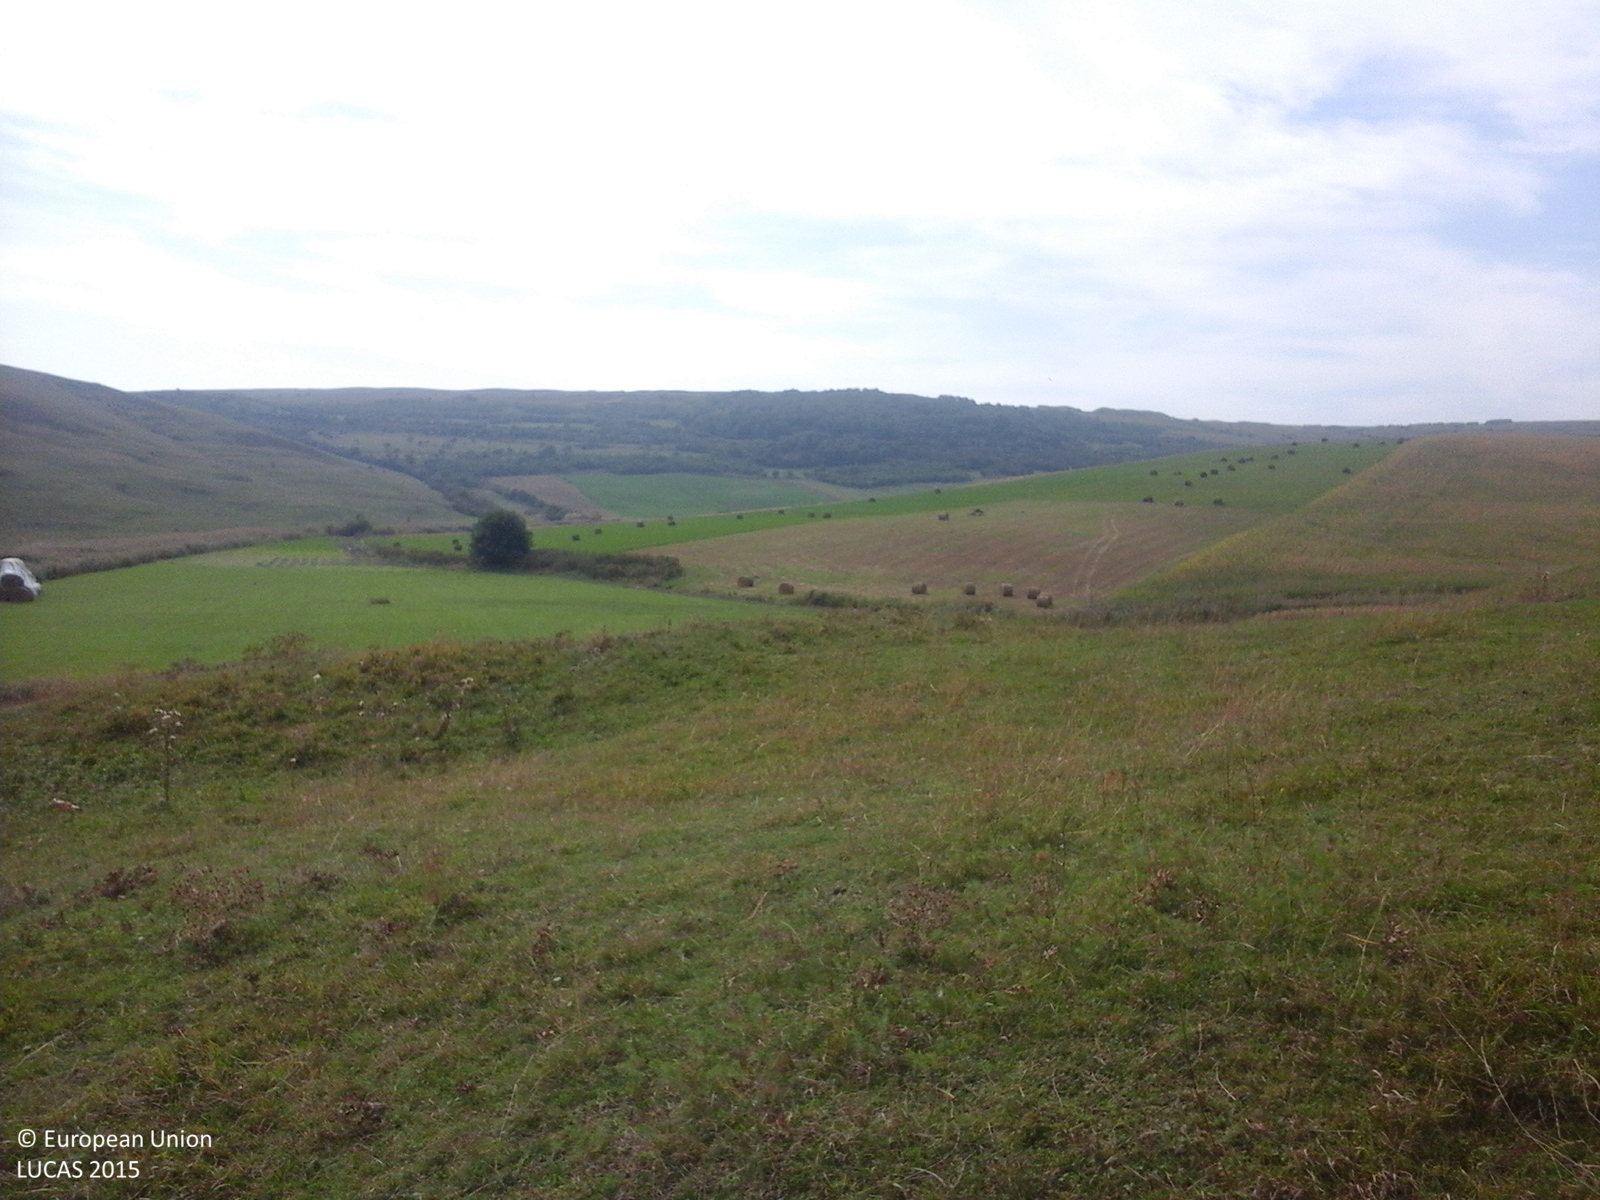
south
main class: Grassland
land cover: Grassland without tree/shrub cover
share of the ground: > 75 %
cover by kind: herbaceous plants 100 %
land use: Agriculture (excluding fallow land and kitchen gardens)
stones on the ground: < 10 %
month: September
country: RO
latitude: 46.7263
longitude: 23.8270
